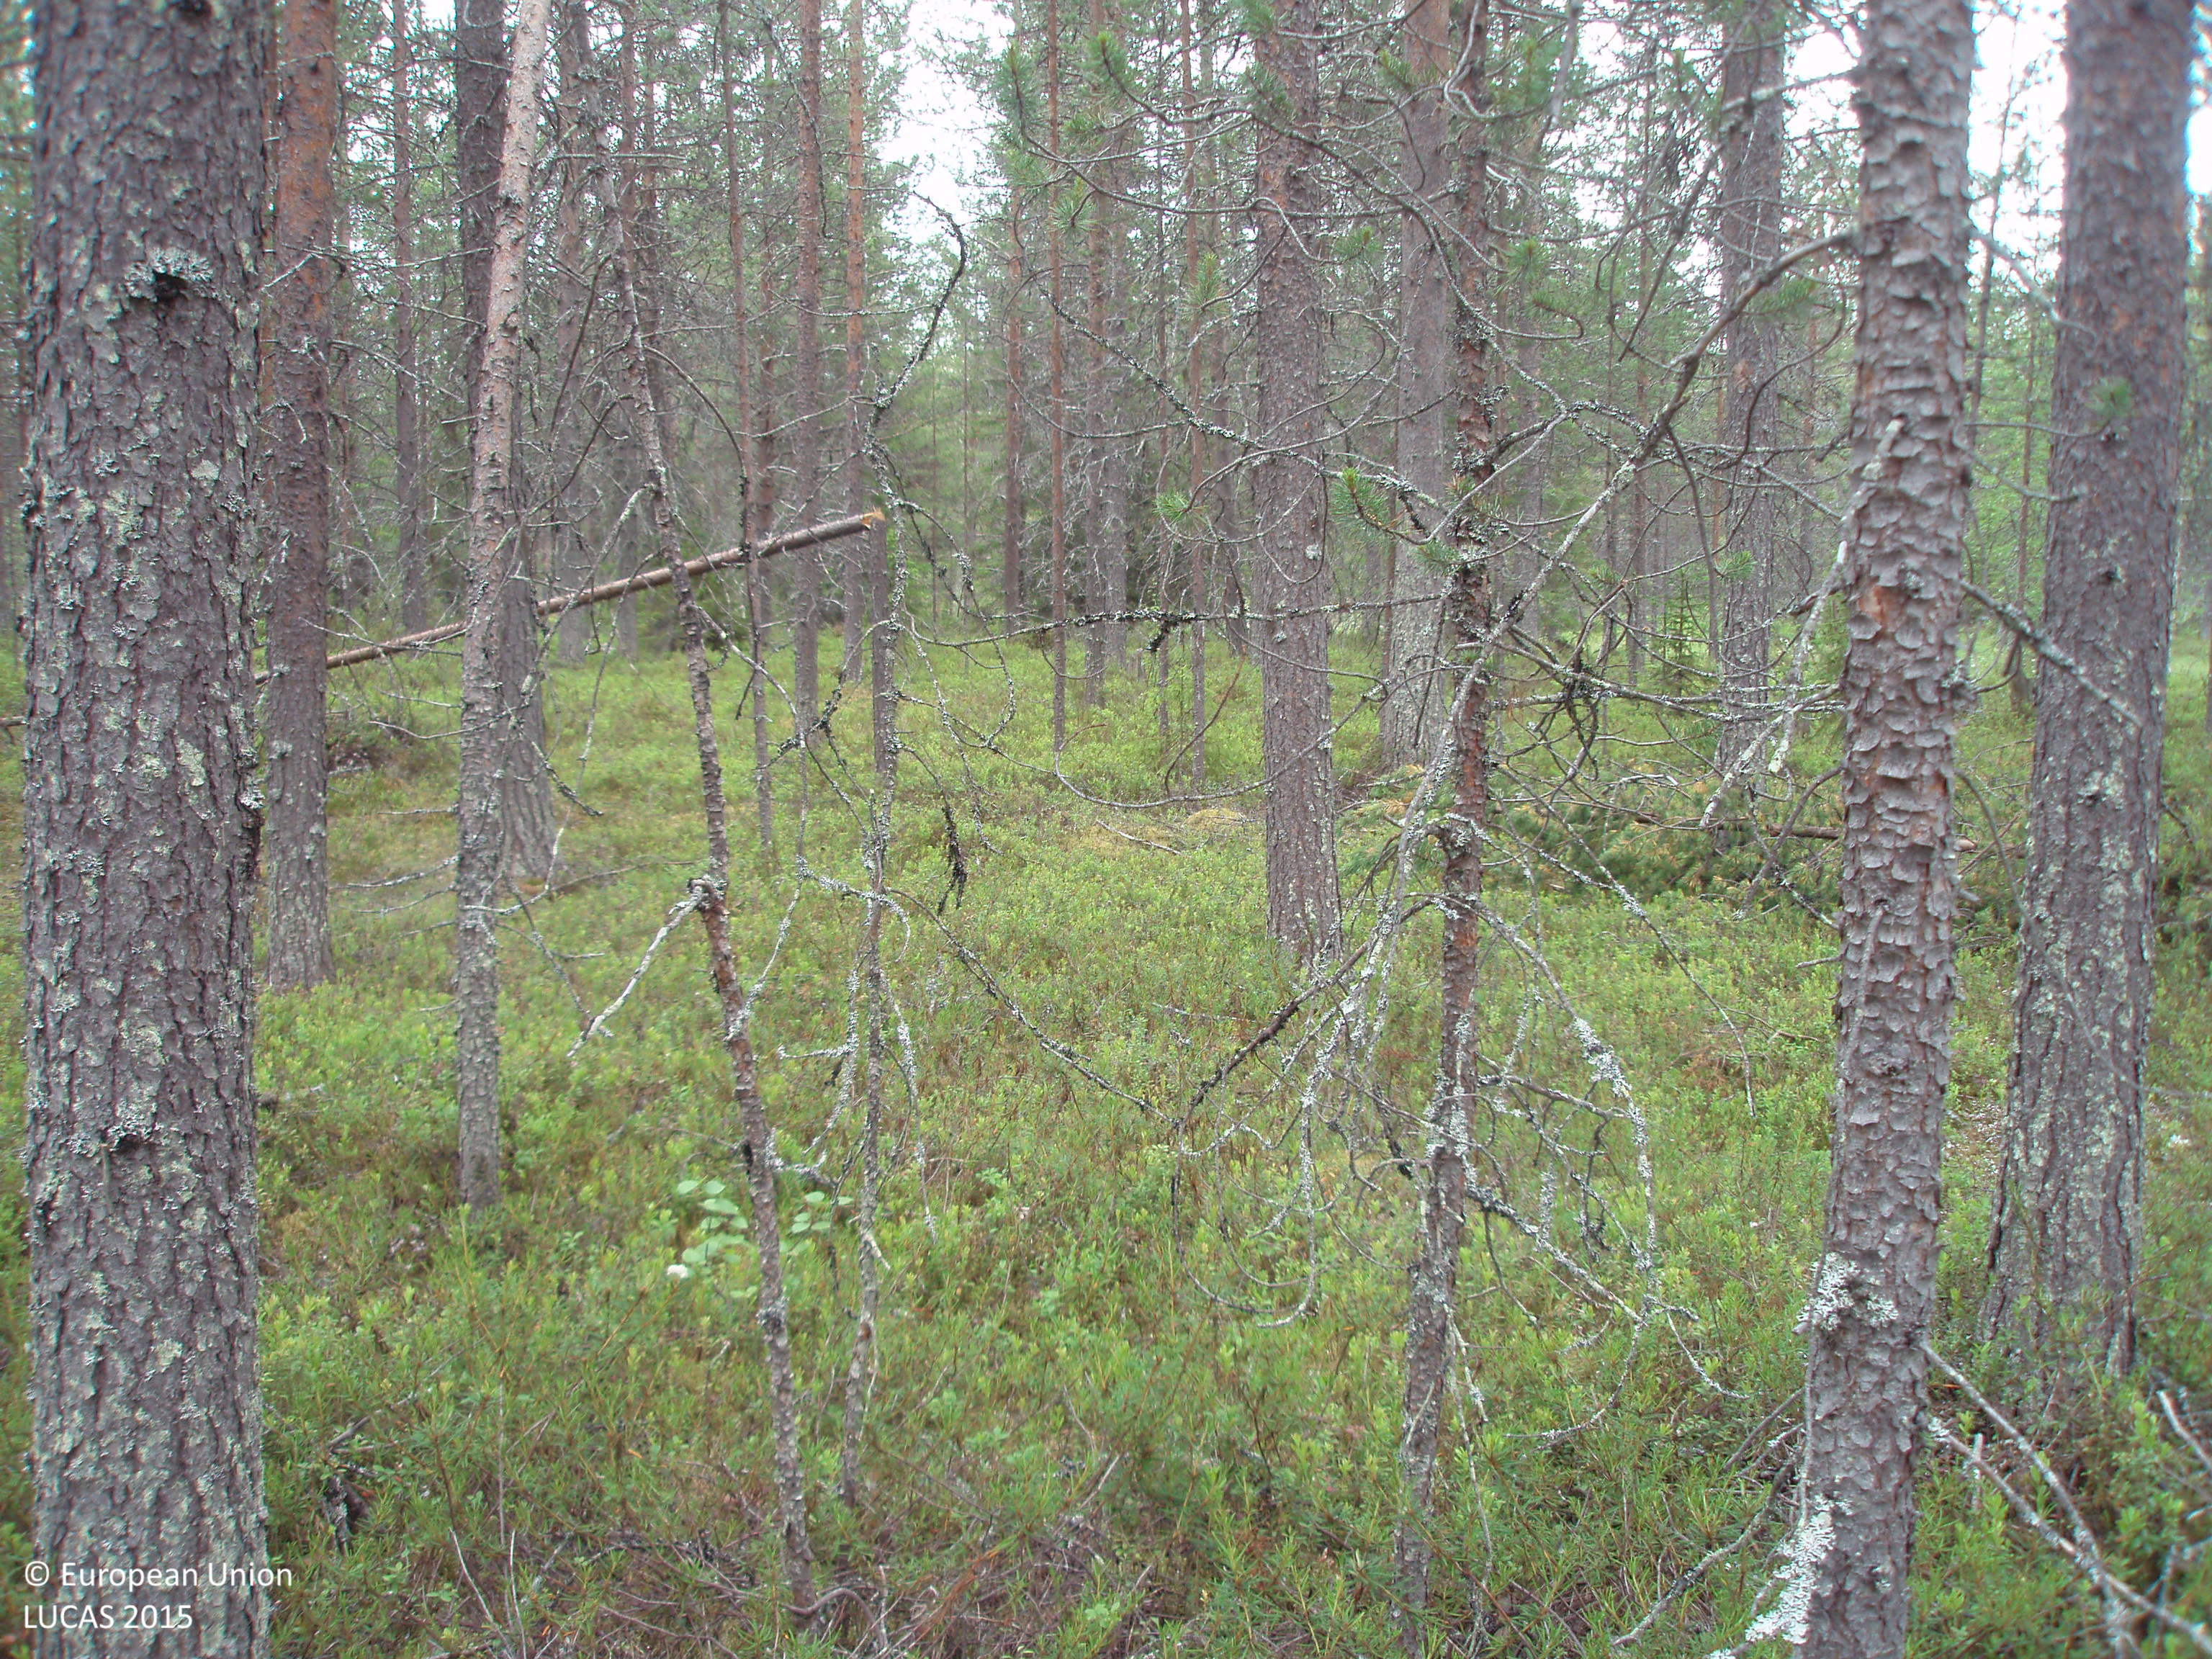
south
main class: Woodland
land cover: Pine dominated coniferous woodland
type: boreal forest
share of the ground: > 75 %
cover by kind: coniferous forest trees 75 %, shrubs 25 %
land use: Forestry
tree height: > 5 m
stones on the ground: < 10 %
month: July
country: FI
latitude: 67.3108
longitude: 28.2202
